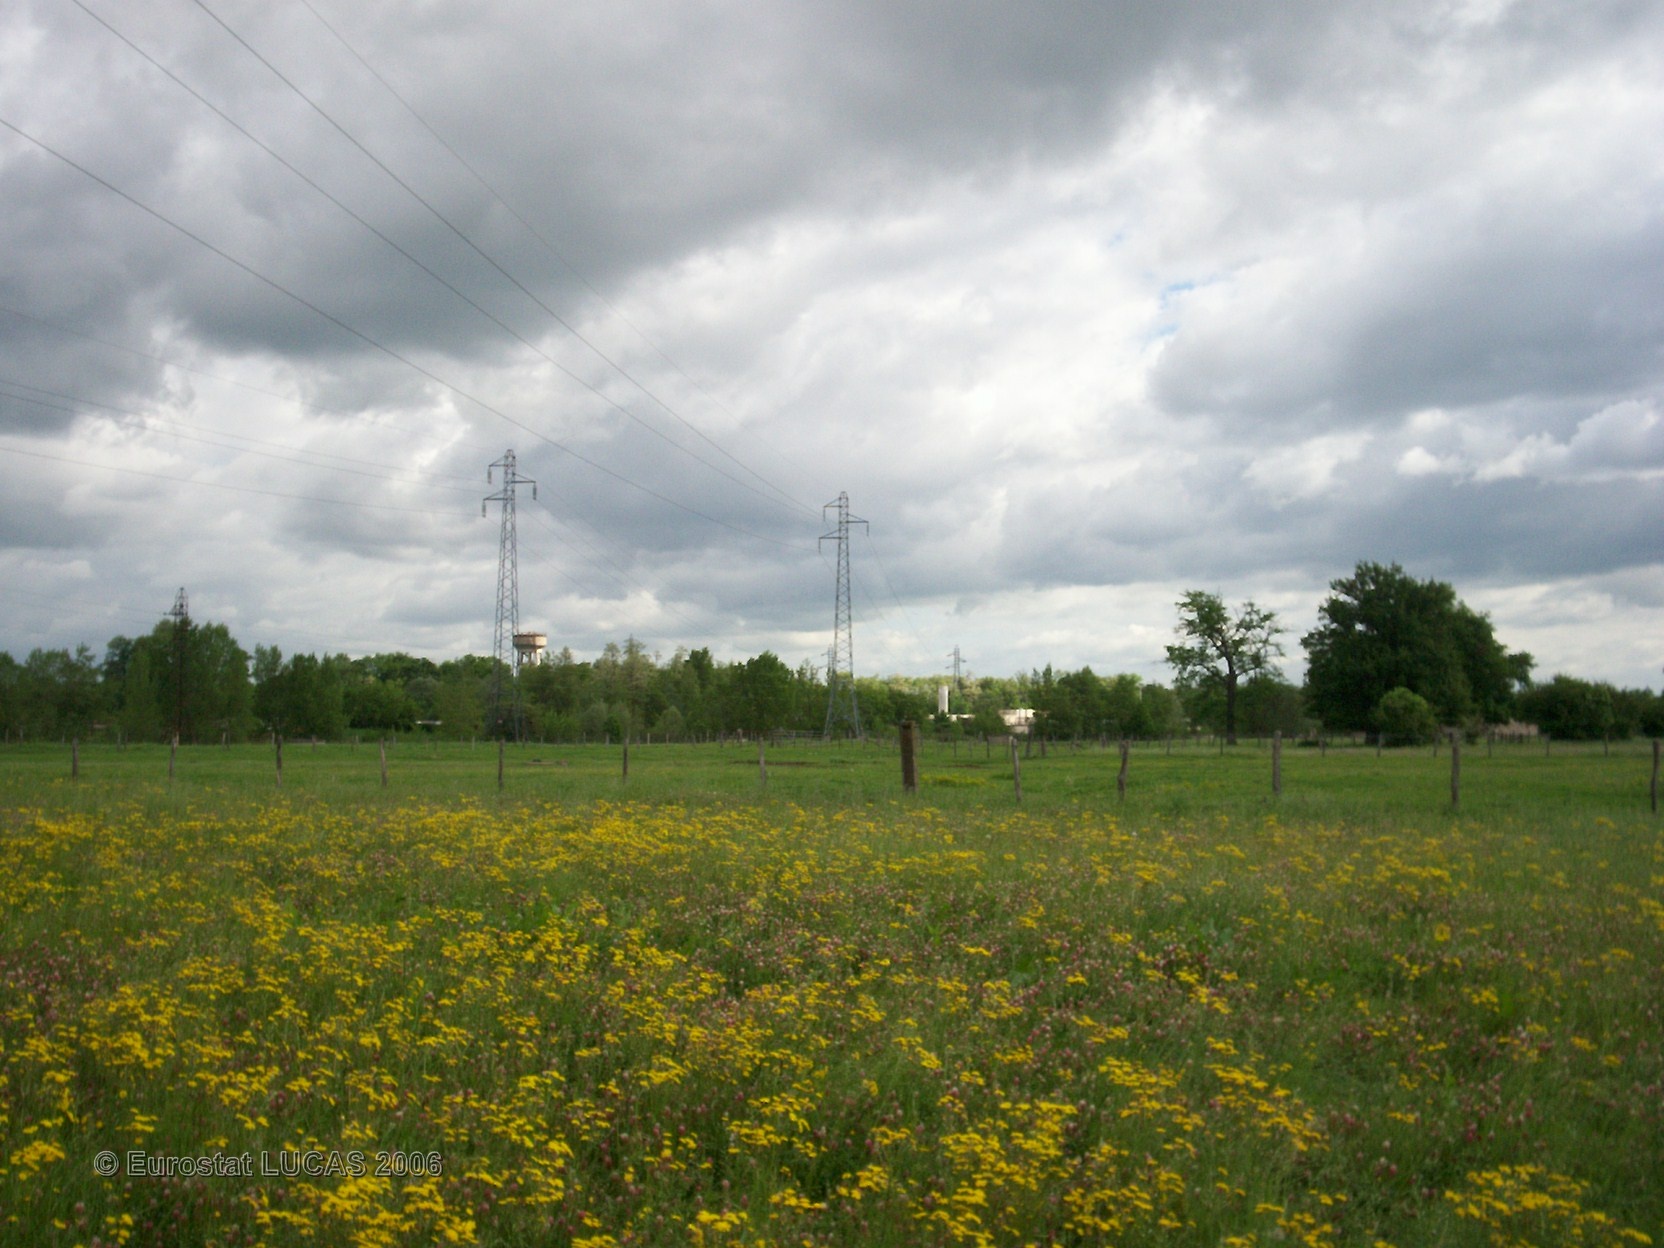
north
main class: Grassland
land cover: Grassland without tree/shrub cover
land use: Agriculture (excluding fallow land and kitchen gardens)
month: May
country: FR
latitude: 46.0436
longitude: 4.0960
